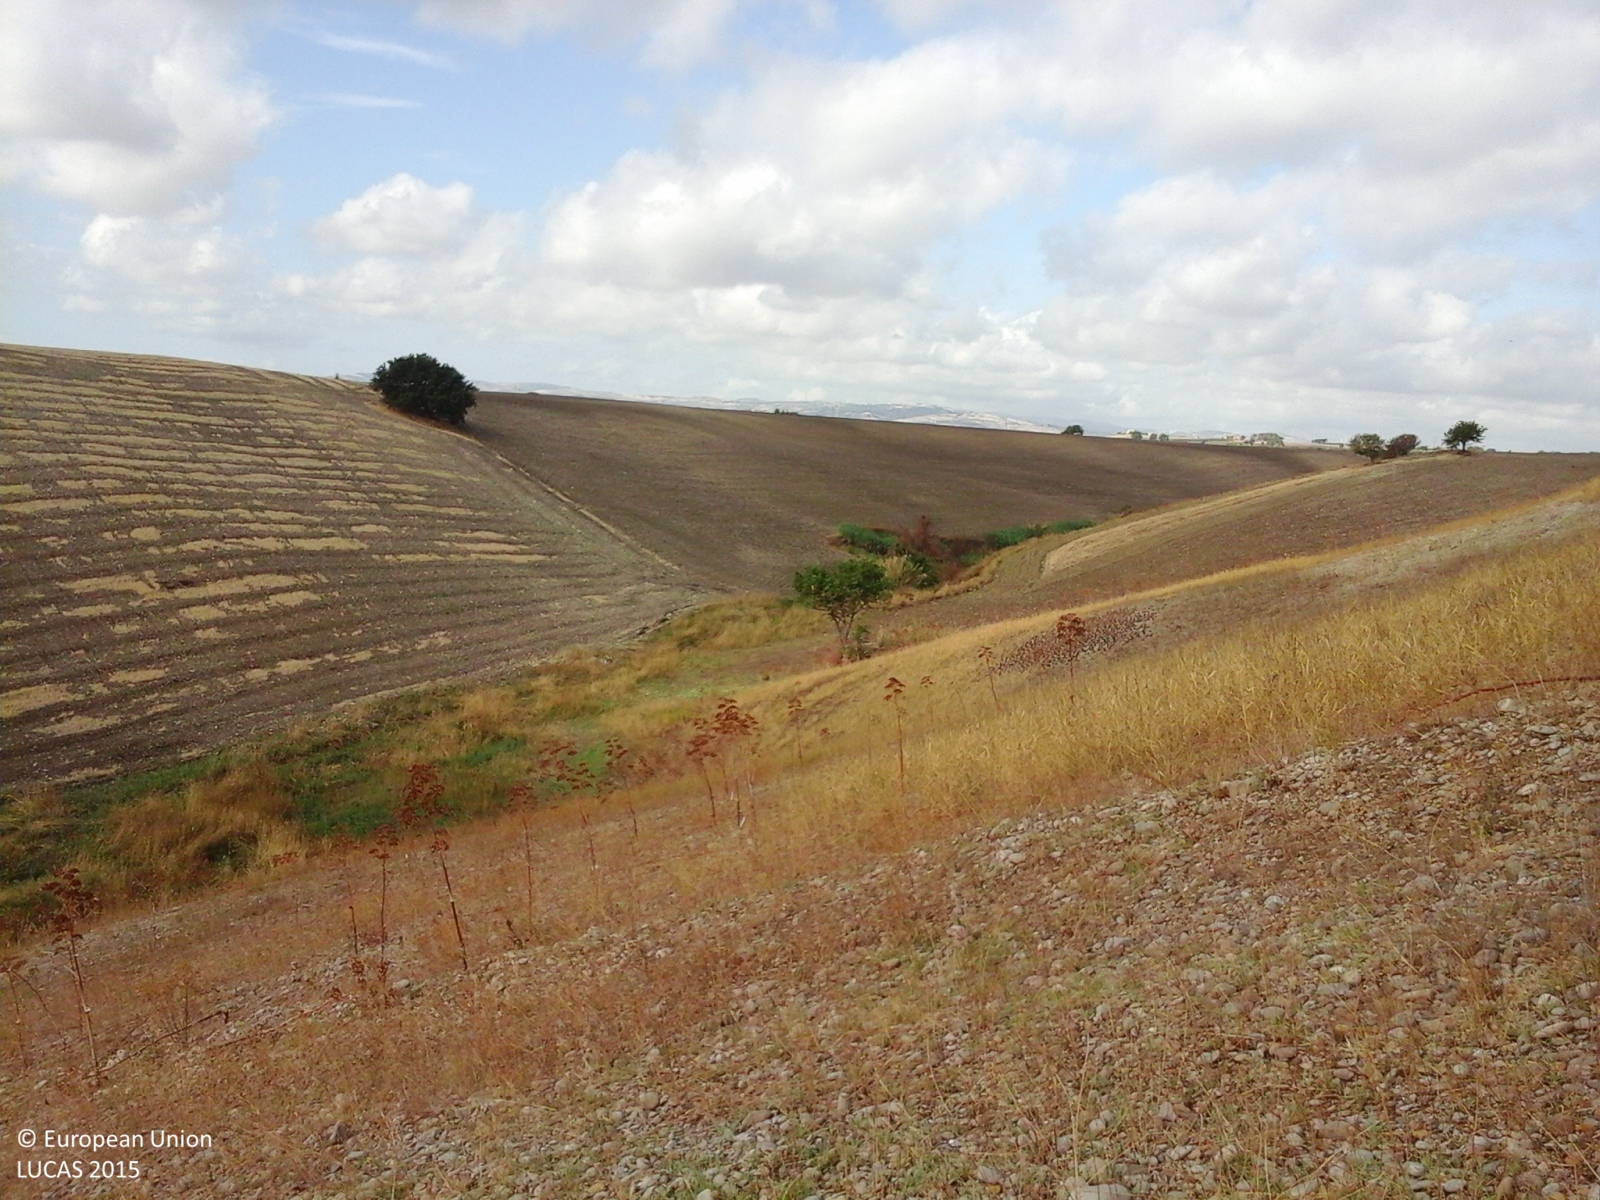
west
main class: Grassland
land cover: Grassland without tree/shrub cover
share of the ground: 50 - 75 %
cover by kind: herbaceous plants 60 %, consolidated bare surface 40 %
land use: Semi-natural and natural areas not in use
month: September
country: IT
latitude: 41.7259
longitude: 15.1647
